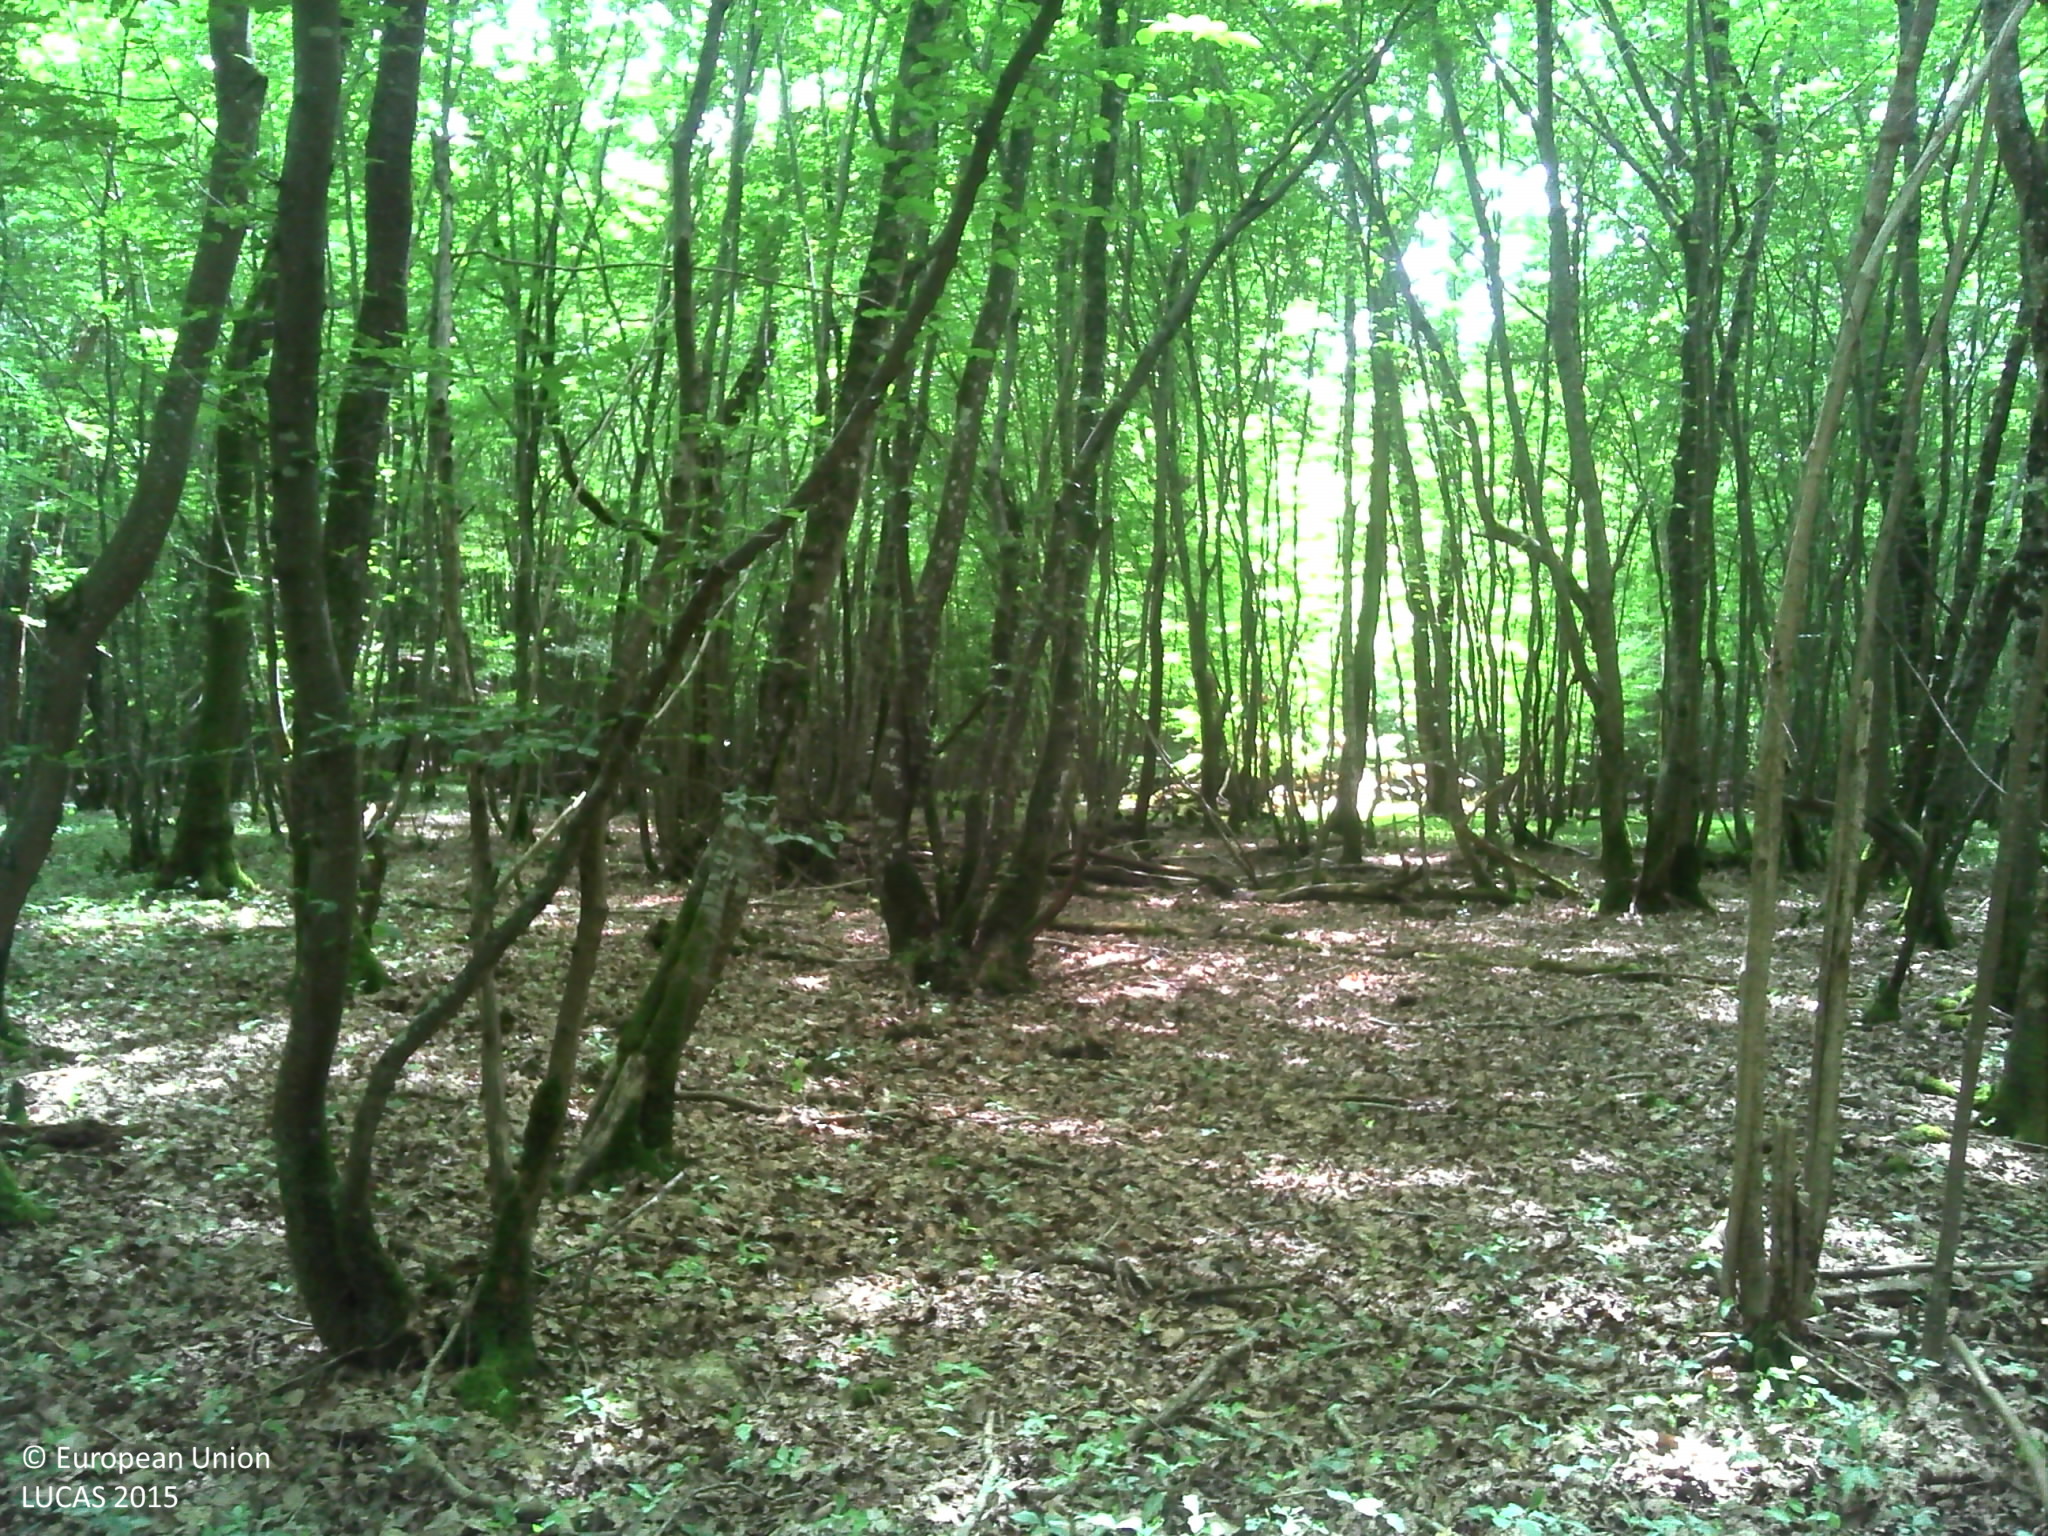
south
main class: Woodland
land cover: Broadleaved woodland
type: mesophytic deciduous forest
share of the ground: > 75 %
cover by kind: broadleaved forest trees 100 %
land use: Forestry
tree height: > 5 m
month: June
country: FR
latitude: 47.0601
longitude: 2.9780
